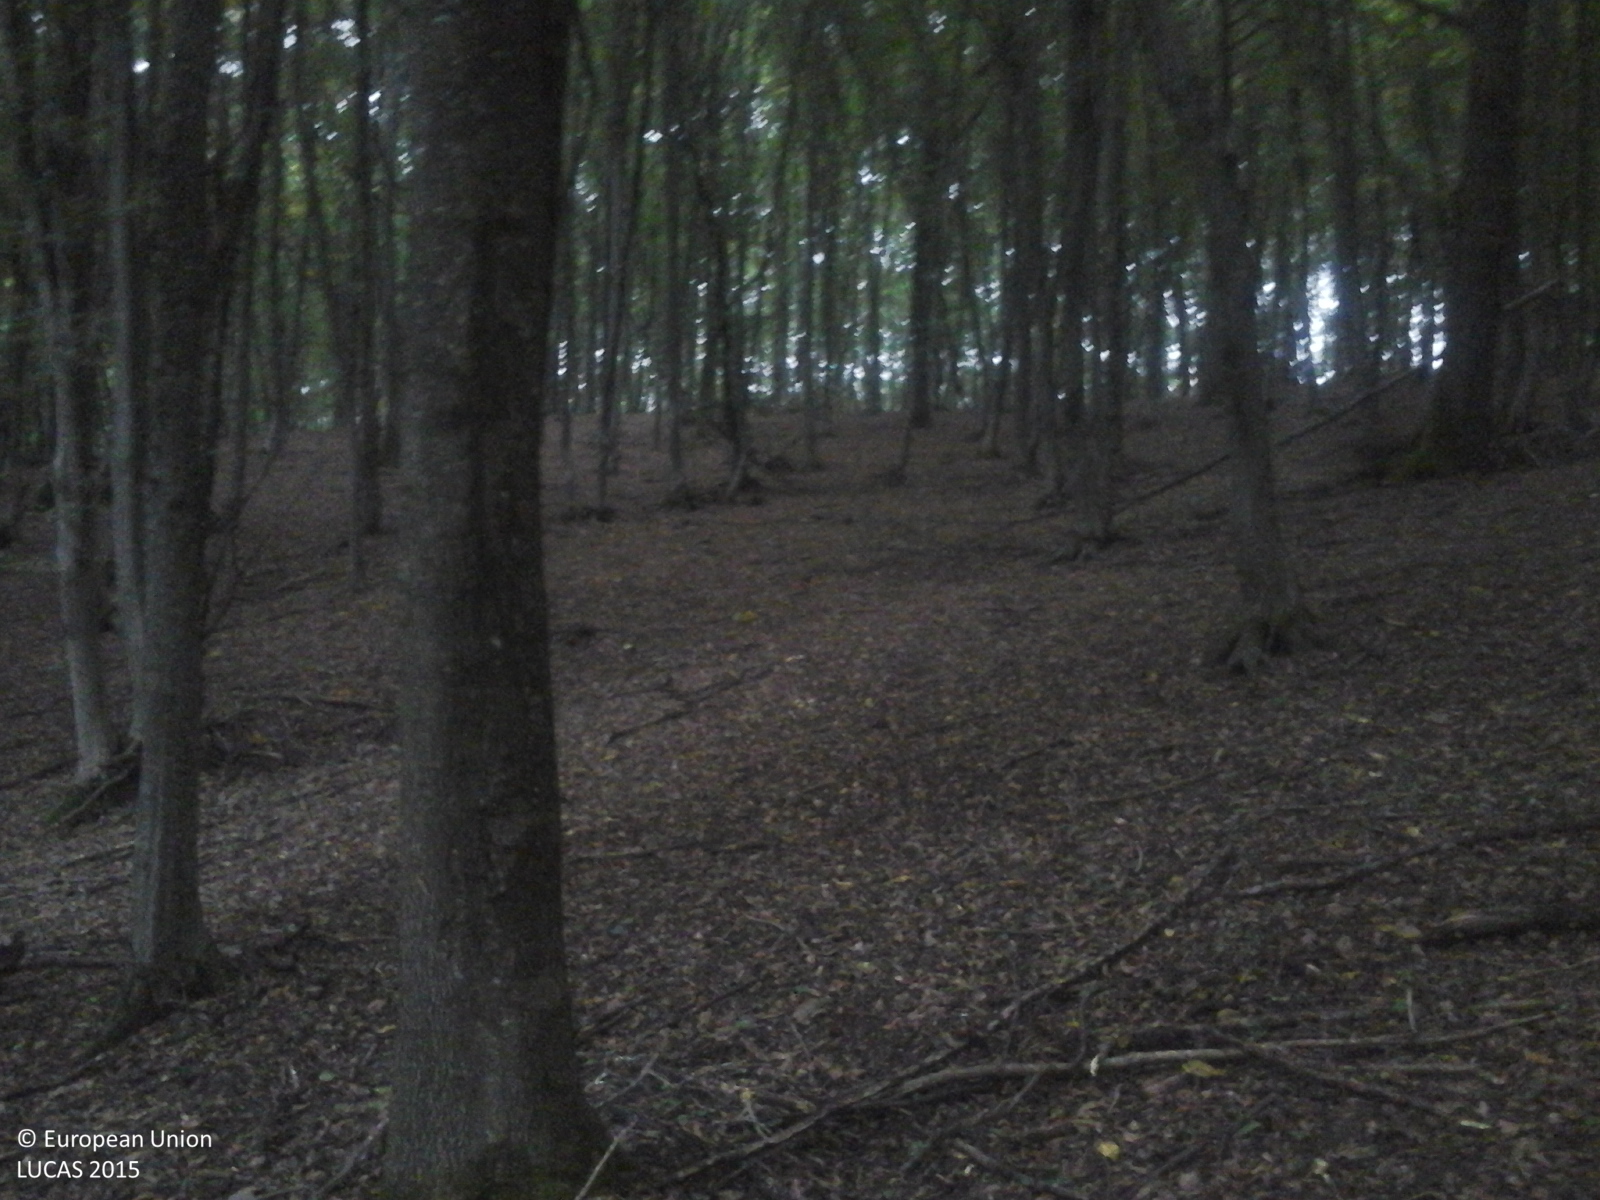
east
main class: Woodland
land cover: Broadleaved woodland
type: beech forest
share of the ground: > 75 %
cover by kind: broadleaved forest trees 100 %
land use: Forestry
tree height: > 5 m
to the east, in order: Broadleaved woodland
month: October
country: RO
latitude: 46.4364
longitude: 24.7598
